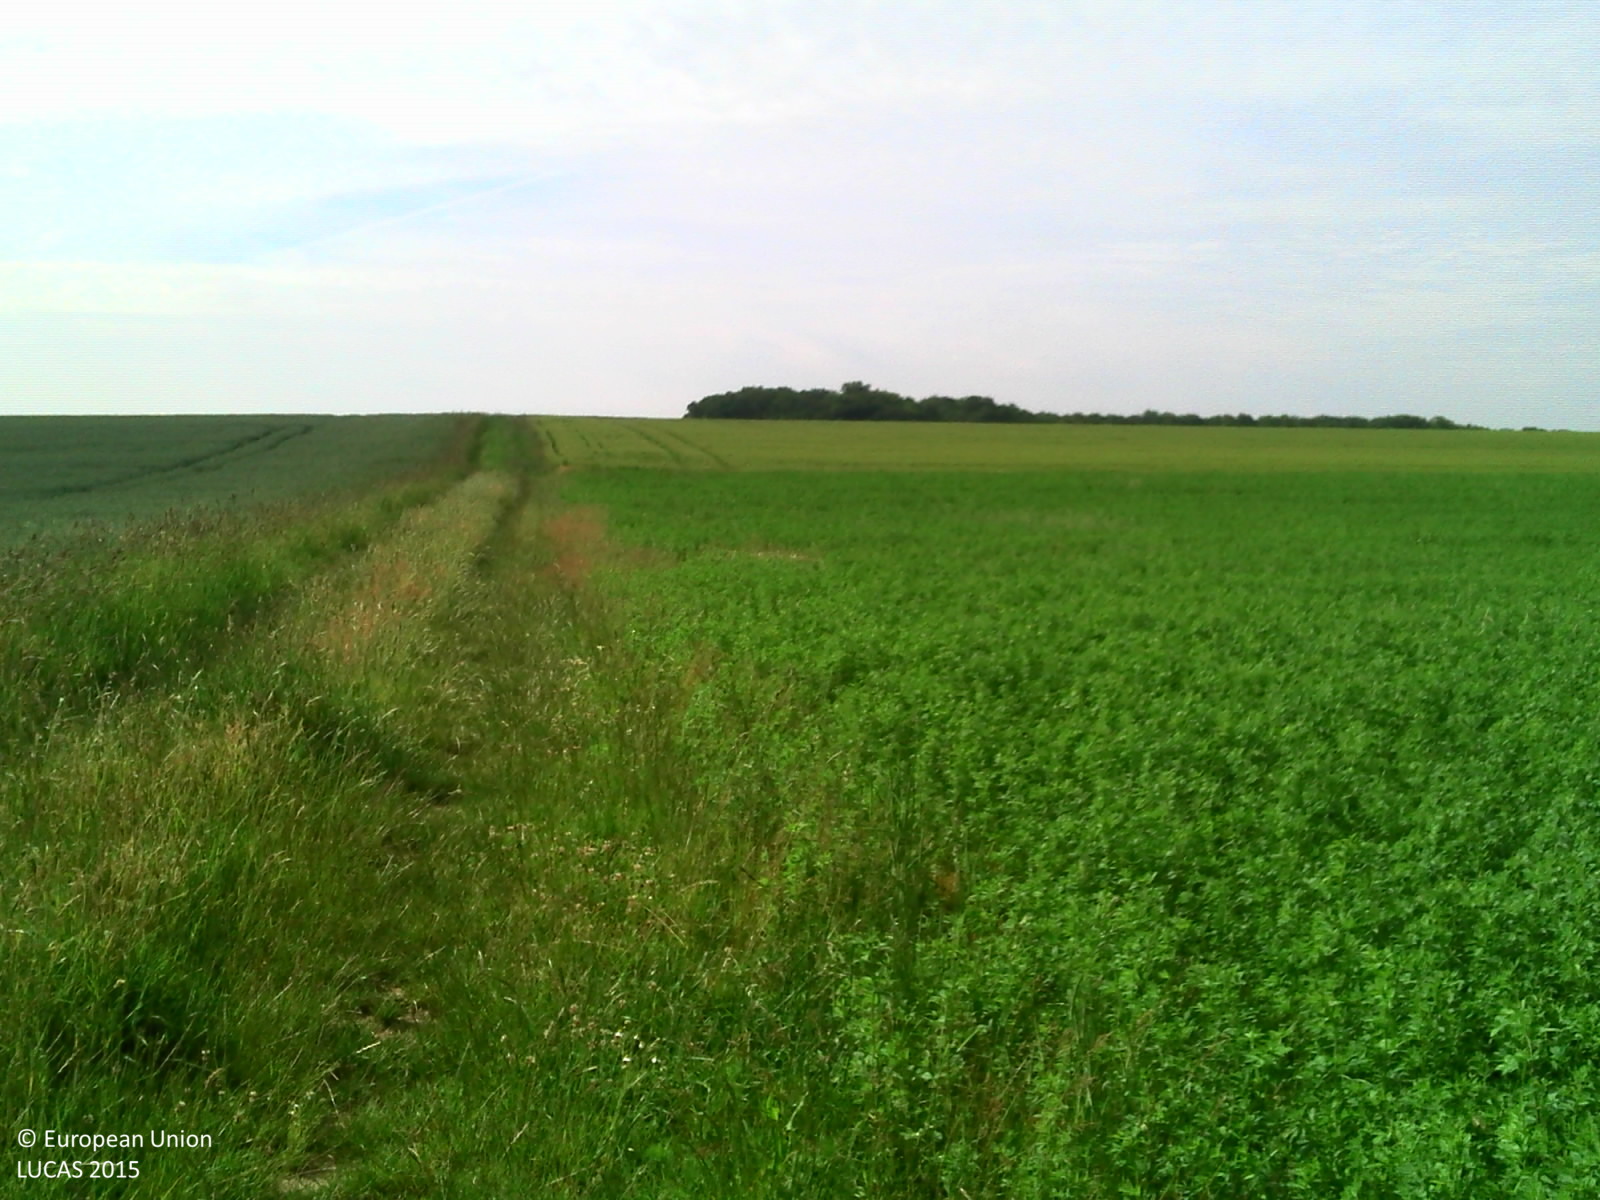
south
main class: Cropland
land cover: Common wheat
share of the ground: > 75 %
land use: Agriculture (excluding fallow land and kitchen gardens)
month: June
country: LU
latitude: 49.7810
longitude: 6.2637
